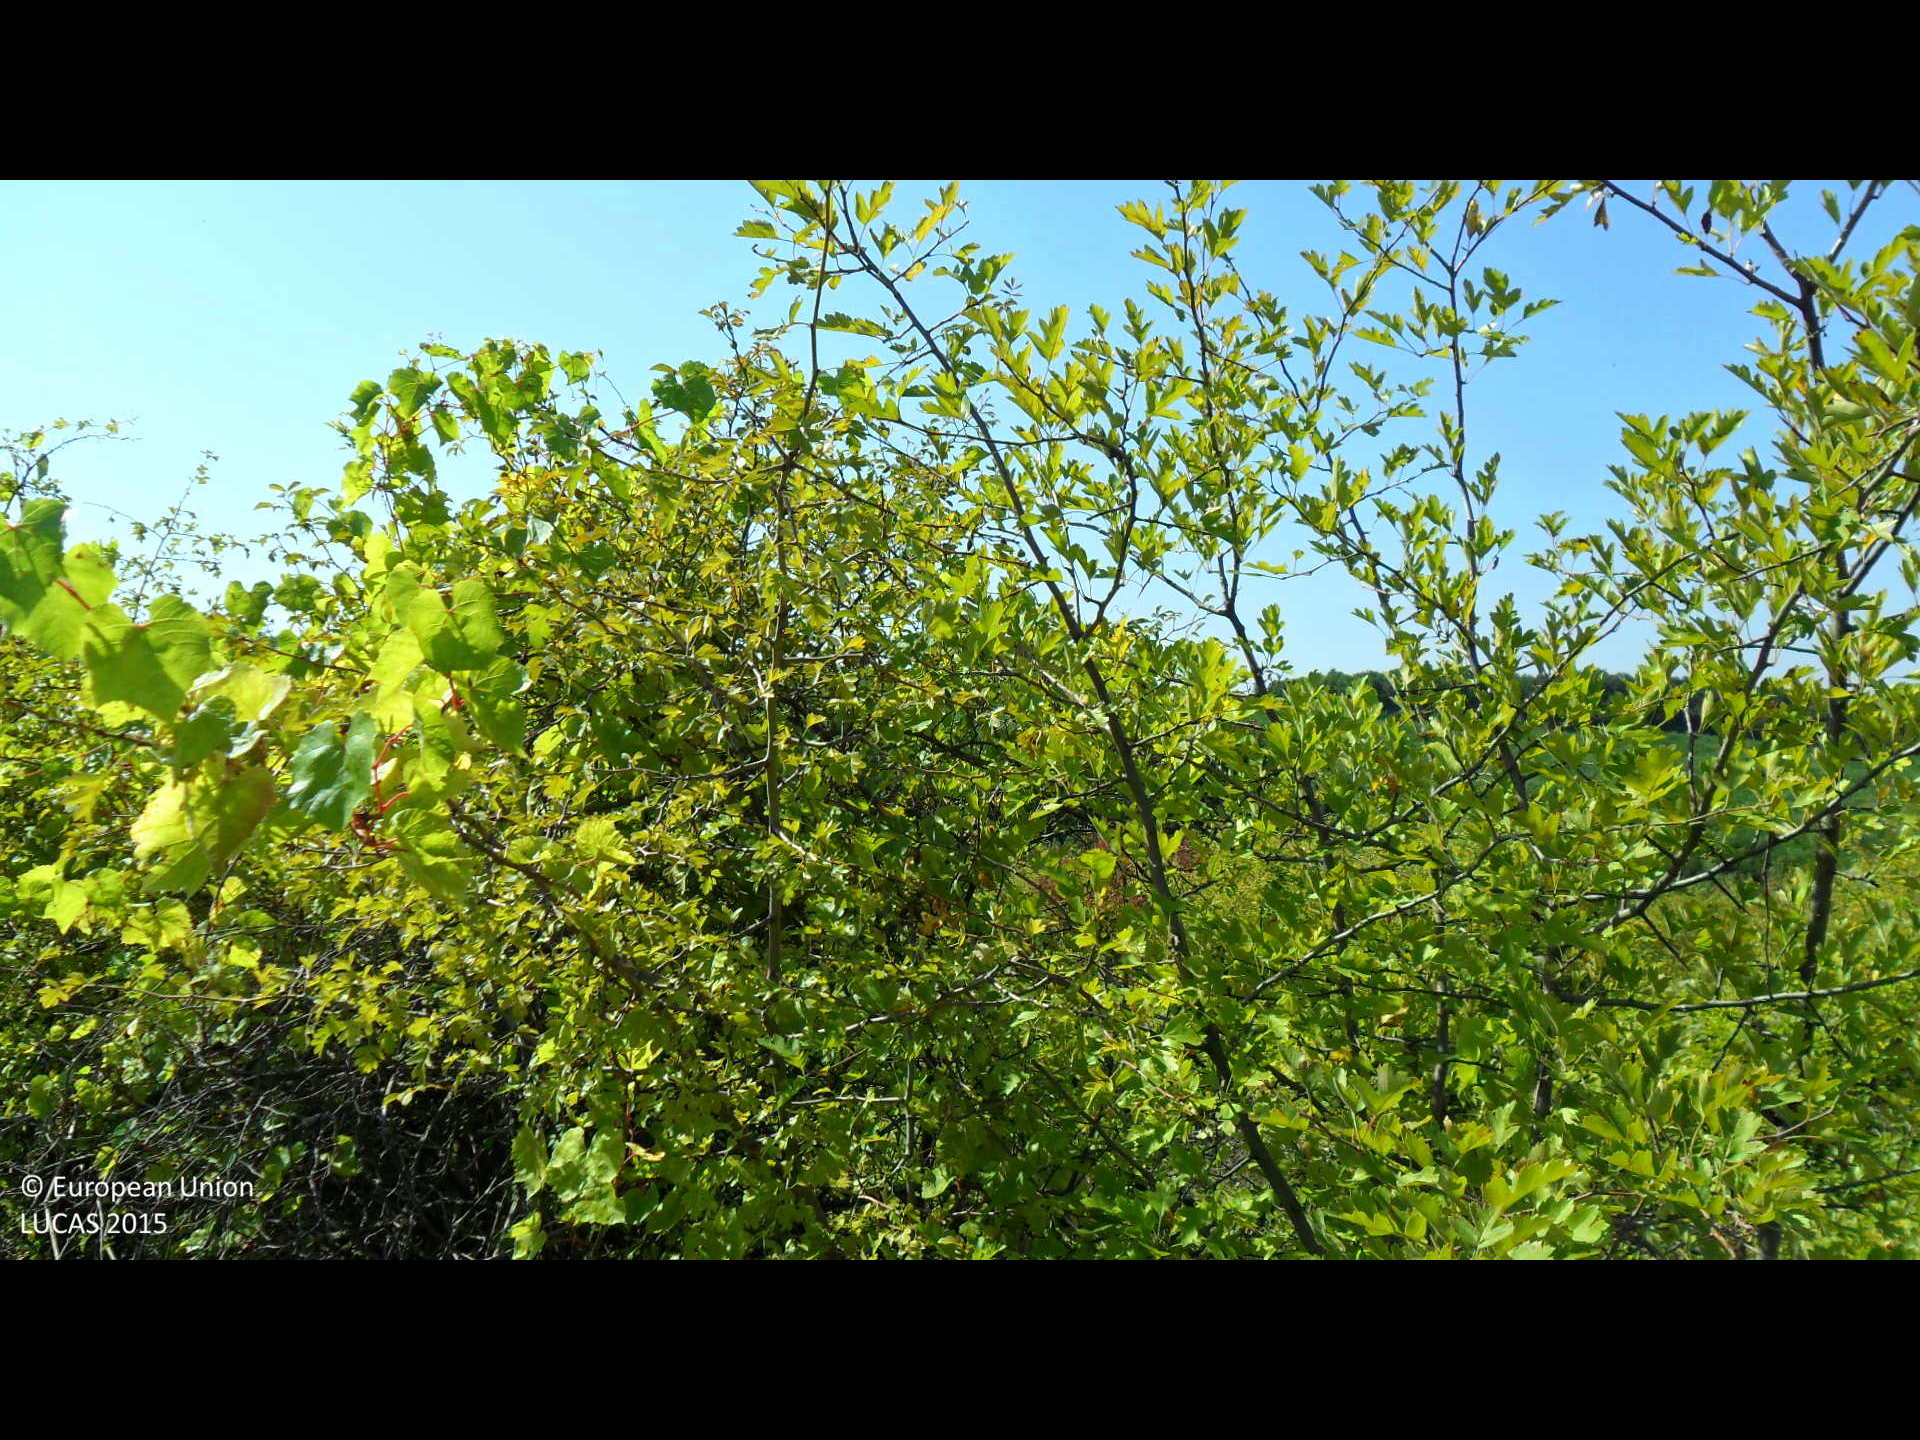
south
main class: Cropland
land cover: Vineyards
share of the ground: 50 - 75 %
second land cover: Shrubland without tree cover
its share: 50 - 75 %
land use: Abandoned areas
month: August
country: BG
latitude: 43.4922
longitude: 26.1850
